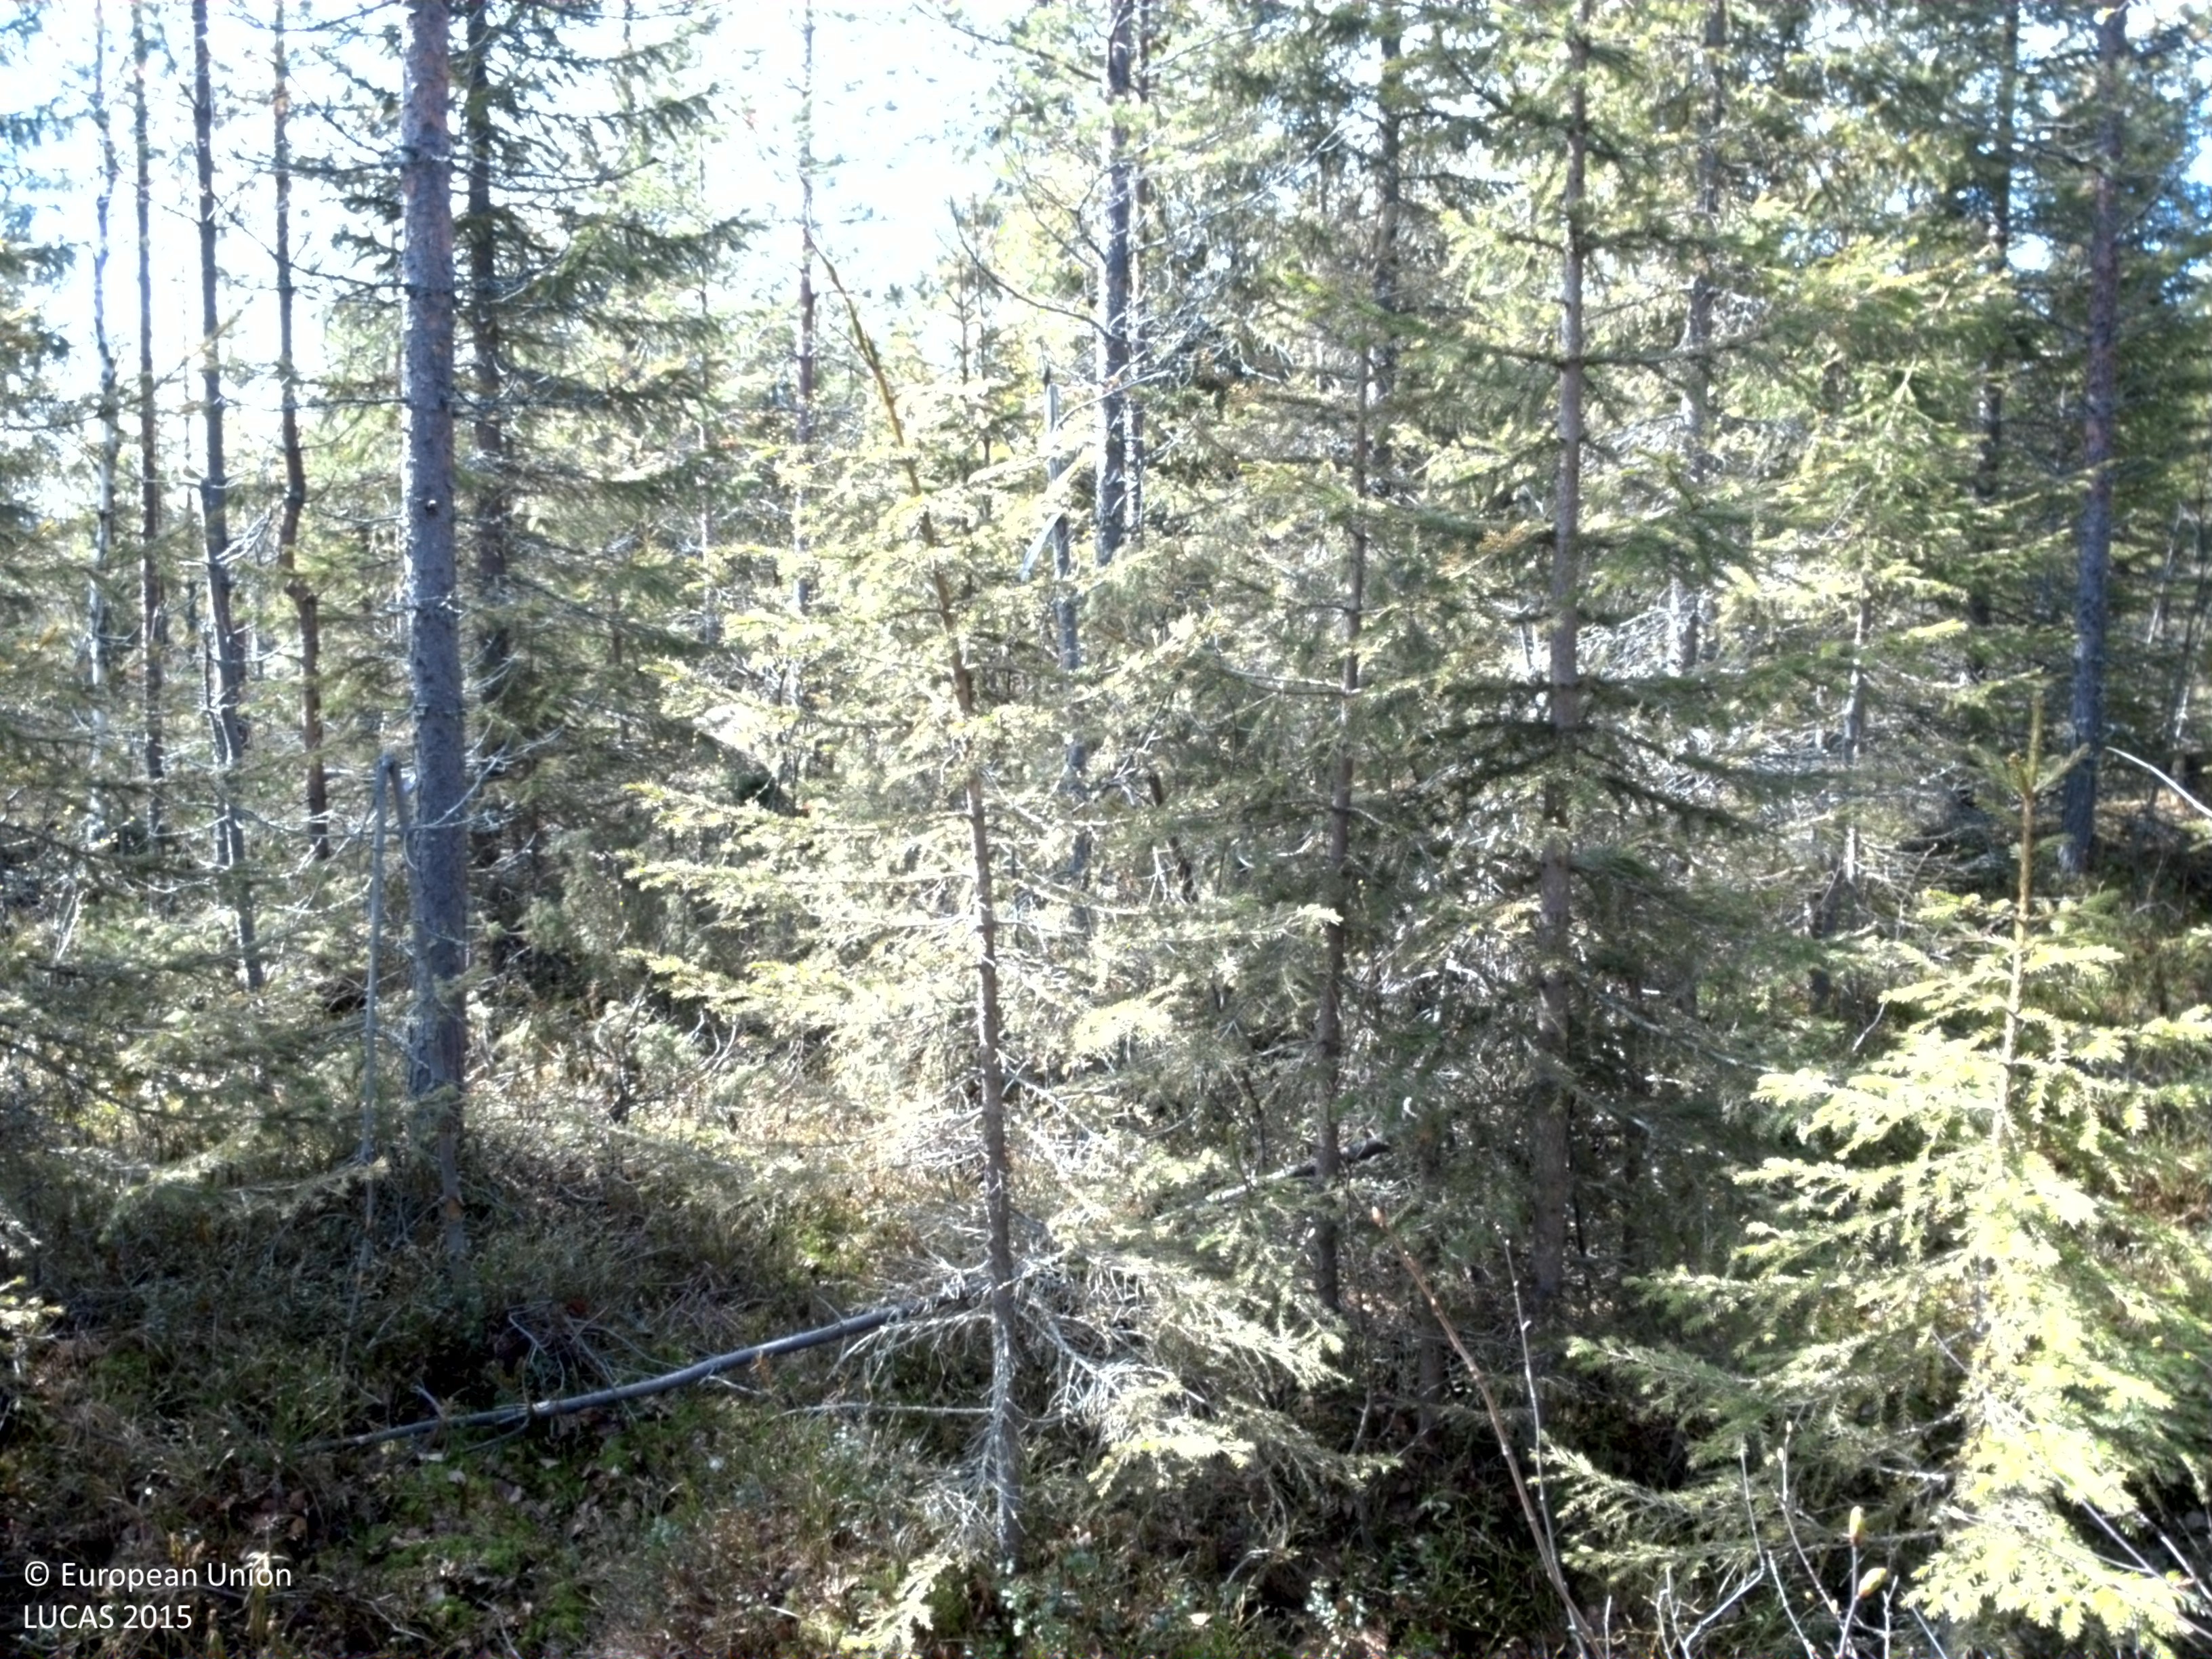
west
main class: Woodland
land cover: Pine dominated coniferous woodland
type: boreal forest
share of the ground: 50 - 75 %
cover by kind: coniferous forest trees 55 %, shrubs 35 %, broadleaved forest trees 10 %
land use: Forestry
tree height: < 5 m
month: May
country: SE
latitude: 66.1552
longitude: 23.2642
